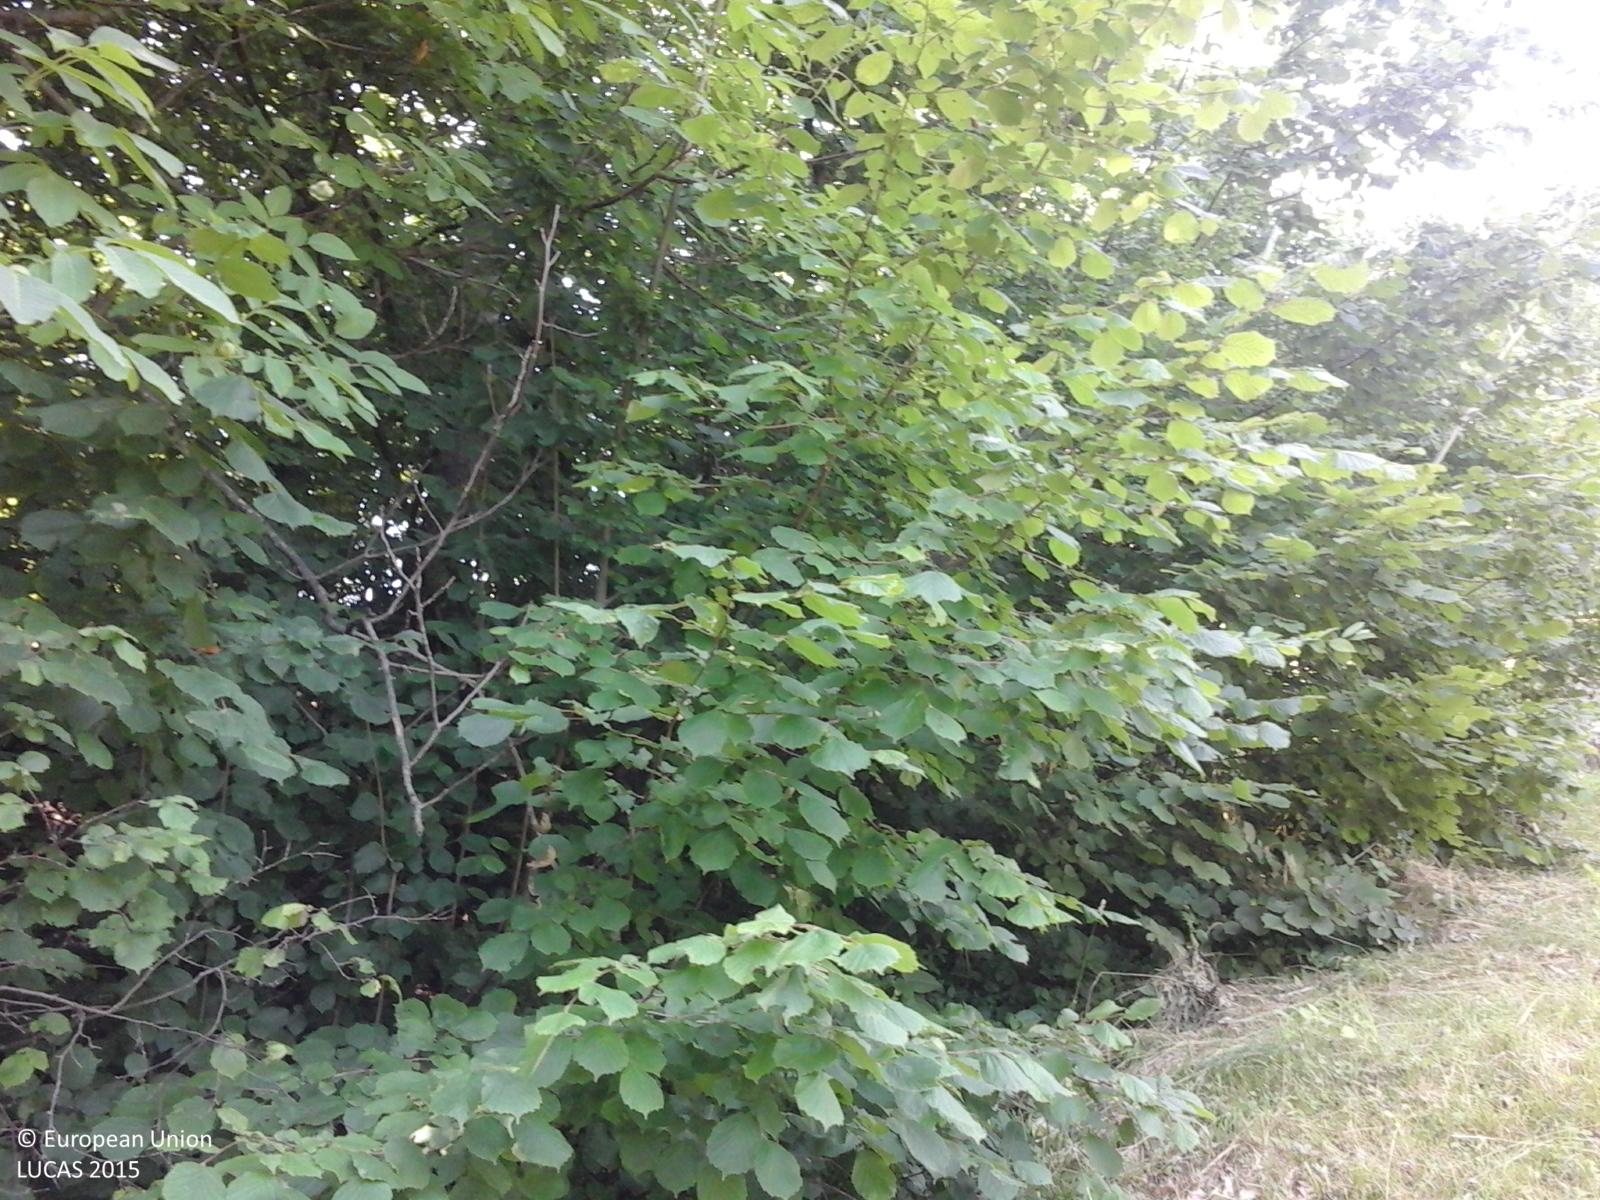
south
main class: Woodland
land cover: Broadleaved woodland
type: non-riverine alder, birch or aspen forest
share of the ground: > 75 %
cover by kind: broadleaved forest trees 100 %
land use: Forestry
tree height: > 5 m
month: July
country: RO
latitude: 45.0690
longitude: 24.5953
